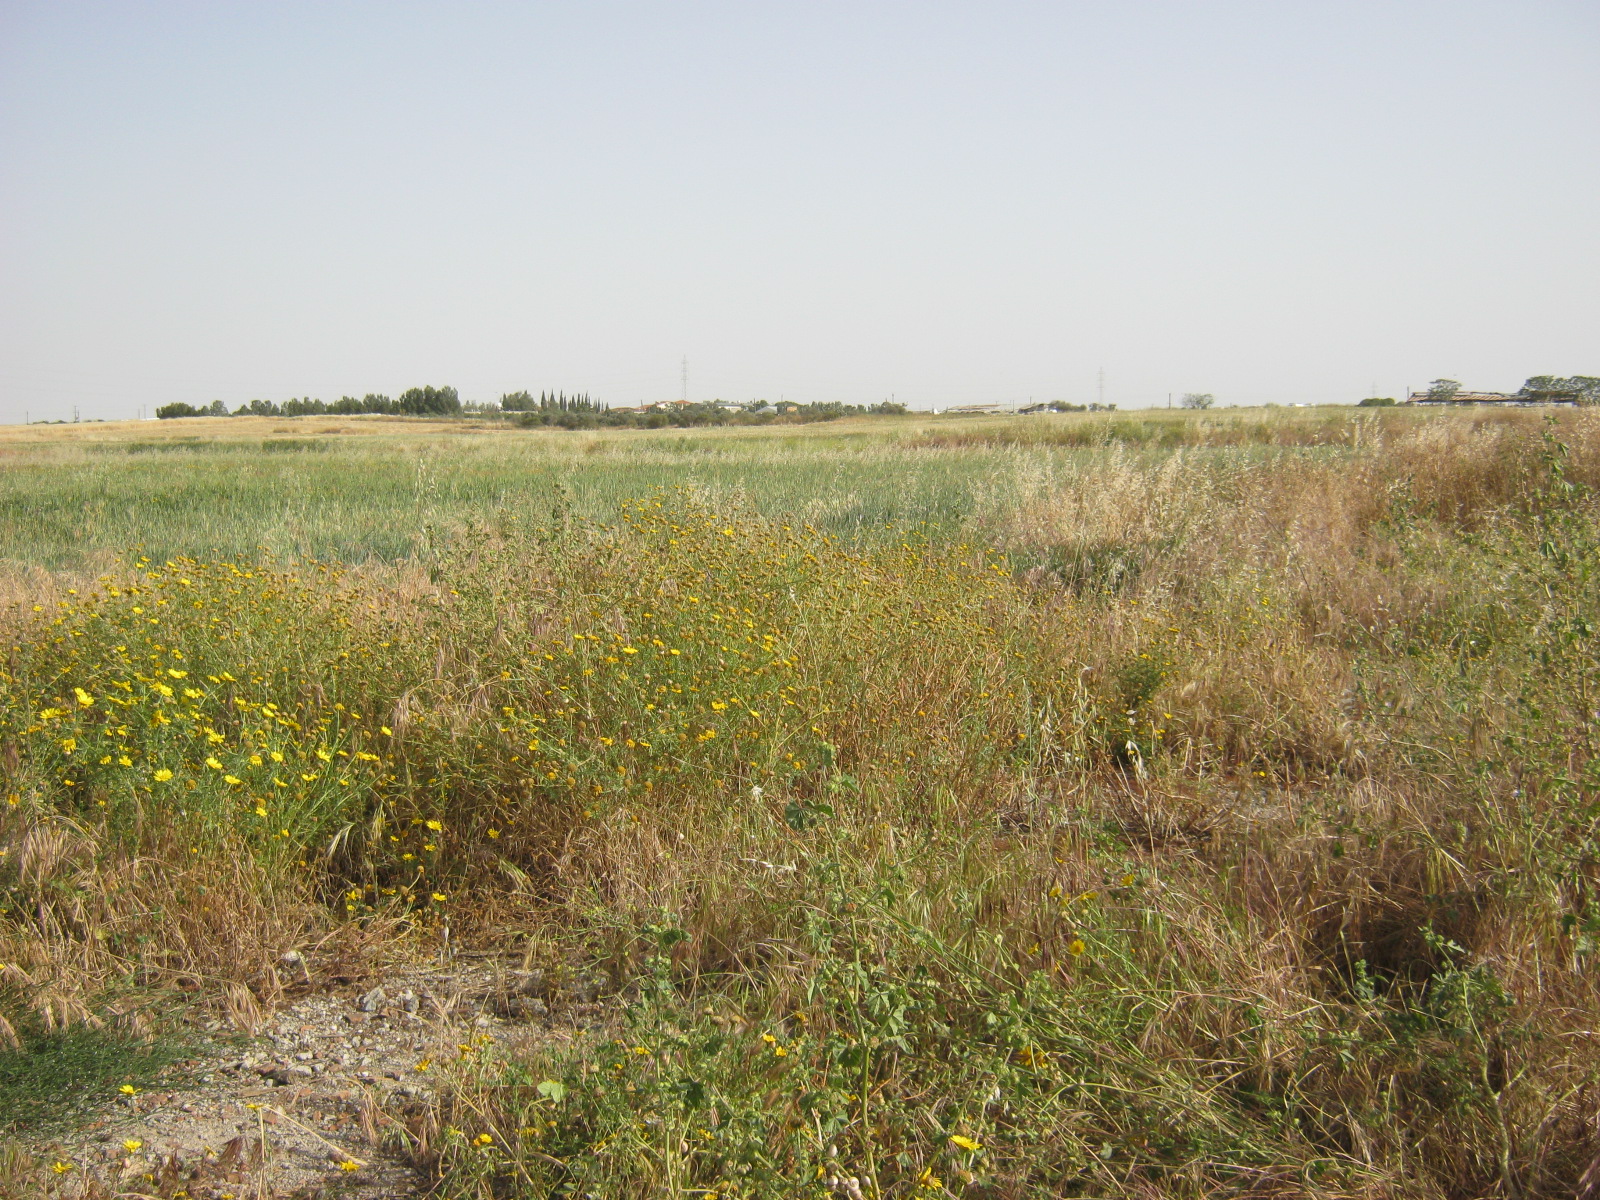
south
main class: Grassland
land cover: Spontaneously vegetated surfaces
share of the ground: > 75 %
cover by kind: herbaceous plants 95 %, unconsolidated bare surface 5 %
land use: Semi-natural and natural areas not in use
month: April
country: CY
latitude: 35.1219
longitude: 33.4021
